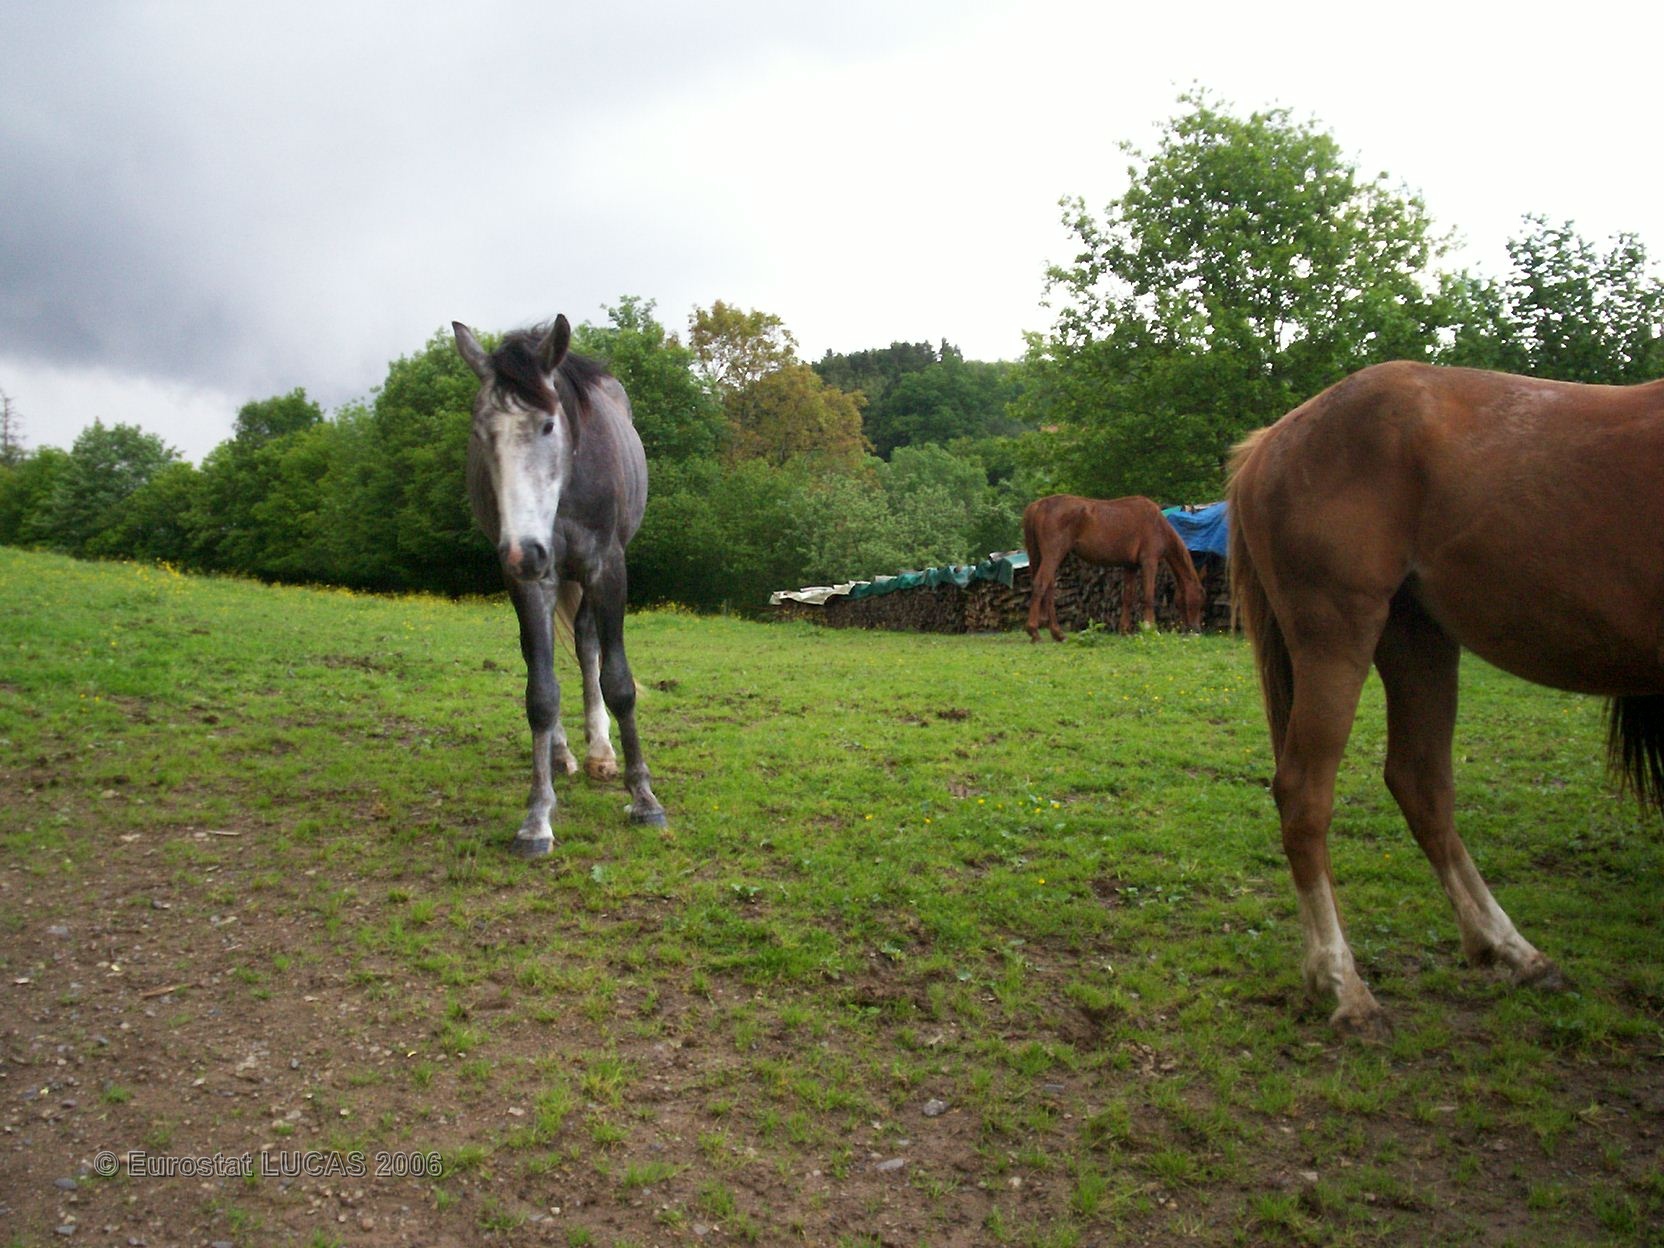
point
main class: Grassland
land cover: Grassland without tree/shrub cover
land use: Agriculture (excluding fallow land and kitchen gardens)
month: May
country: FR
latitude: 48.2935
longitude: 7.1029
